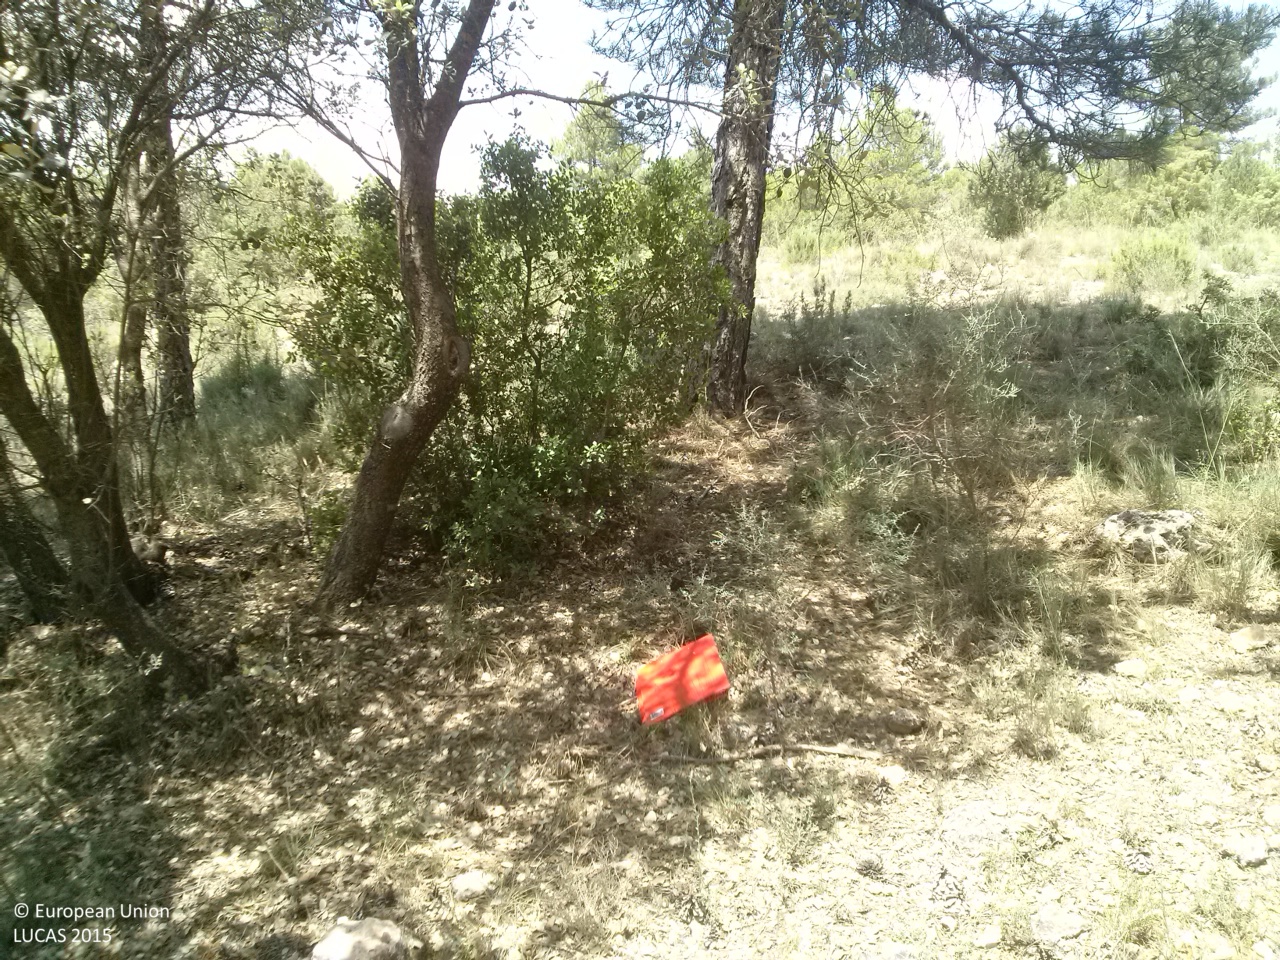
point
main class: Woodland
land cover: Other mixed woodland
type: broadleaved evergreen forest
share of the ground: 25 - 50 %
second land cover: Shrubland without tree cover
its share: 25 - 50 %
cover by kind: shrubs 30 %, coniferous forest trees 25 %, herbaceous plants 20 %, broadleaved forest trees 15 %, unconsolidated bare surface 10 %
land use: Forestry
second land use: Agriculture (excluding fallow land and kitchen gardens)
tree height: > 5 m
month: June
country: ES
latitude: 39.8803
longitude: -1.8089
